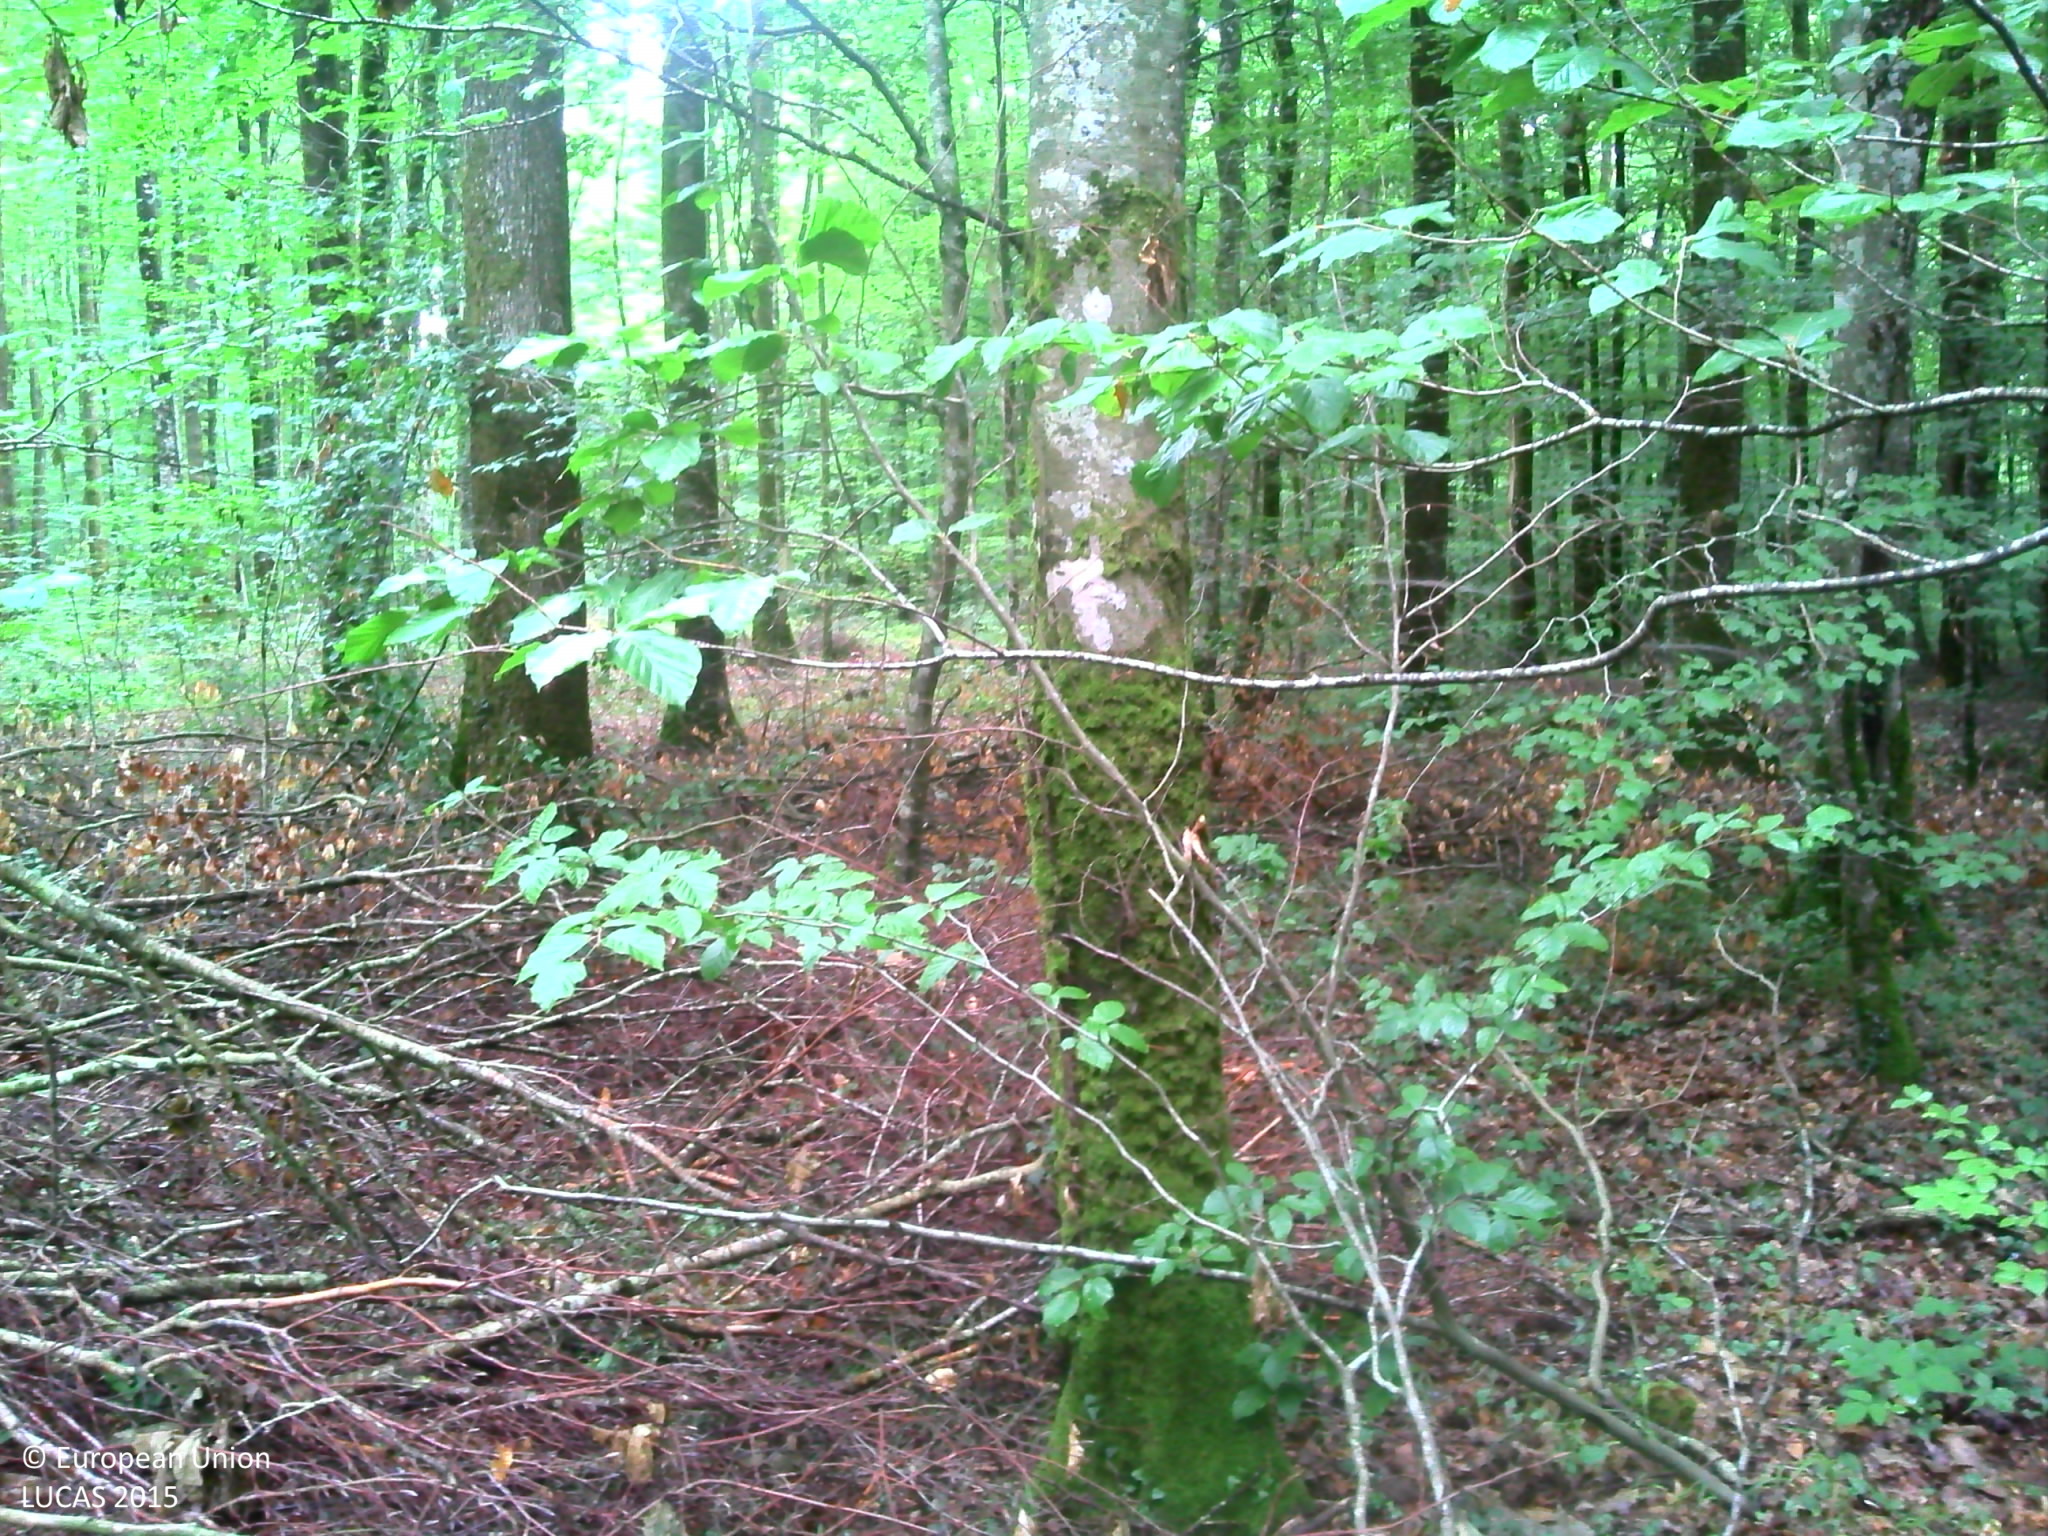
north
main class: Woodland
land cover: Broadleaved woodland
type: beech forest
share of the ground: > 75 %
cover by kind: broadleaved forest trees 95 %, herbaceous plants 5 %
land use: Forestry
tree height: > 5 m
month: July
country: FR
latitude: 47.5530
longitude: -1.7806
